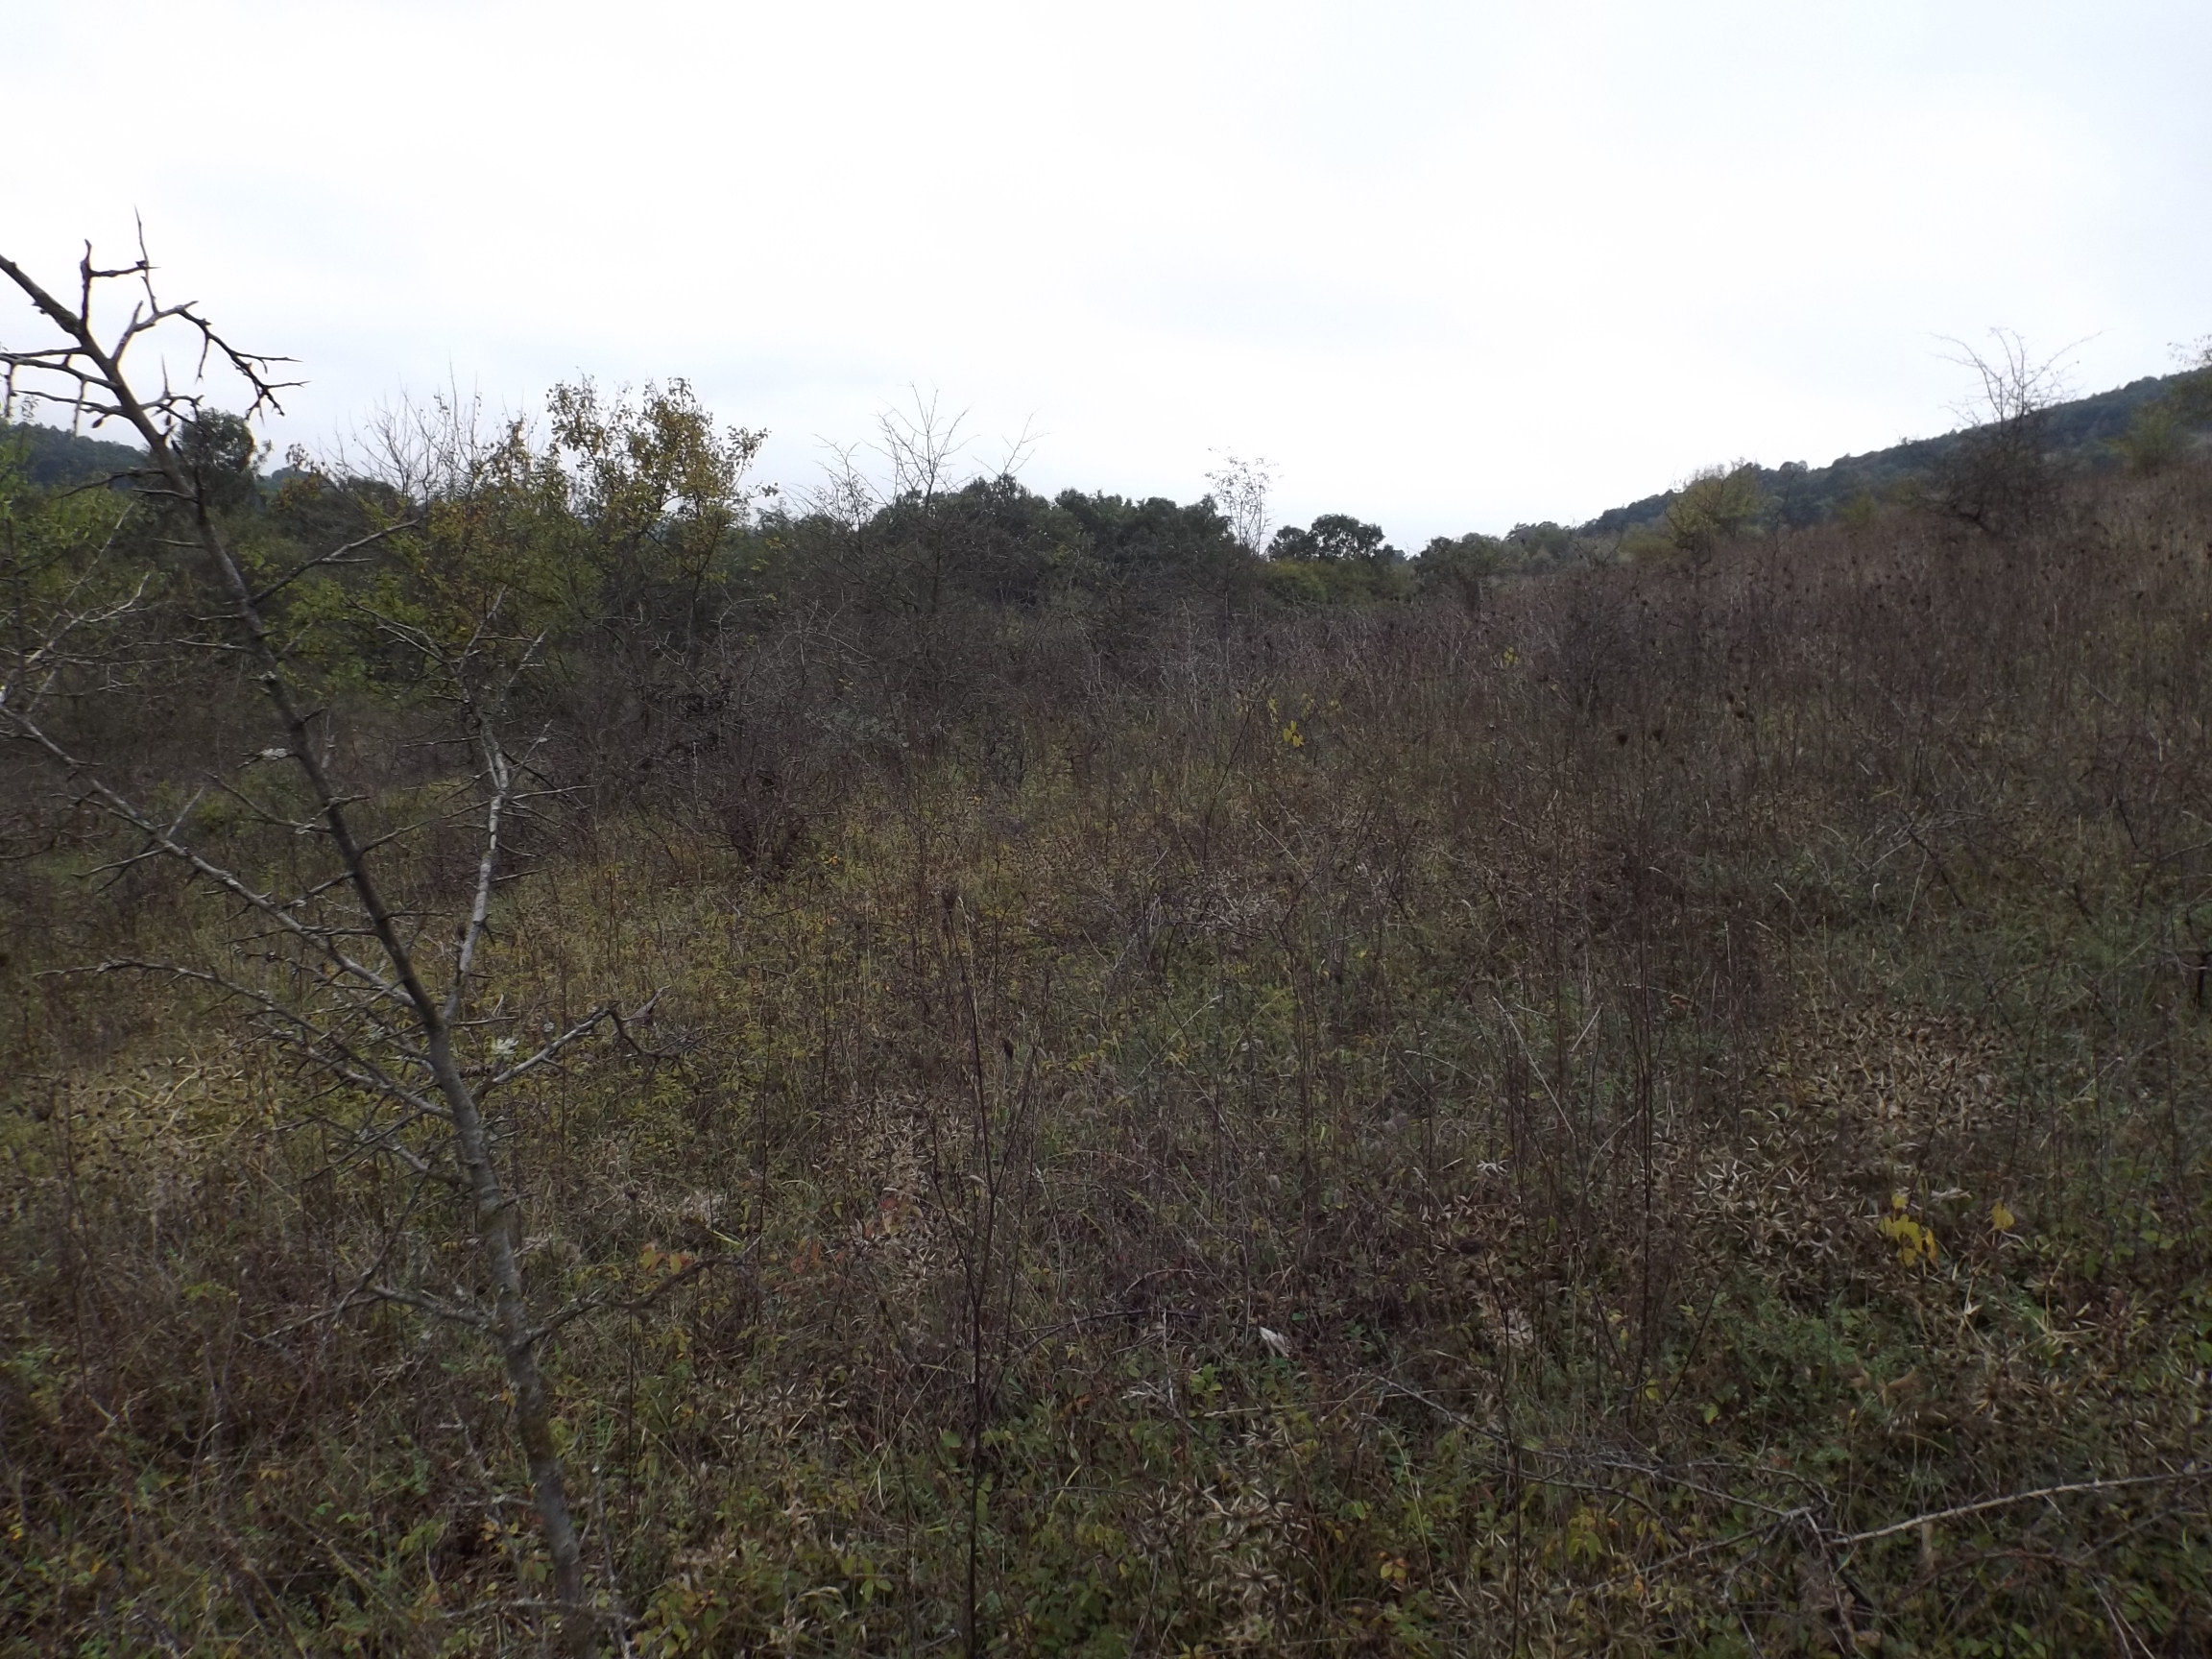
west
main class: Shrubland
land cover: Shrubland with sparse tree cover
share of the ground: 50 - 75 %
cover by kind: shrubs 55 %, herbaceous plants 40 %, broadleaved forest trees 5 %
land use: Semi-natural and natural areas not in use
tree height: > 5 m
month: October
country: BG
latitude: 43.0320
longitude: 27.1884
